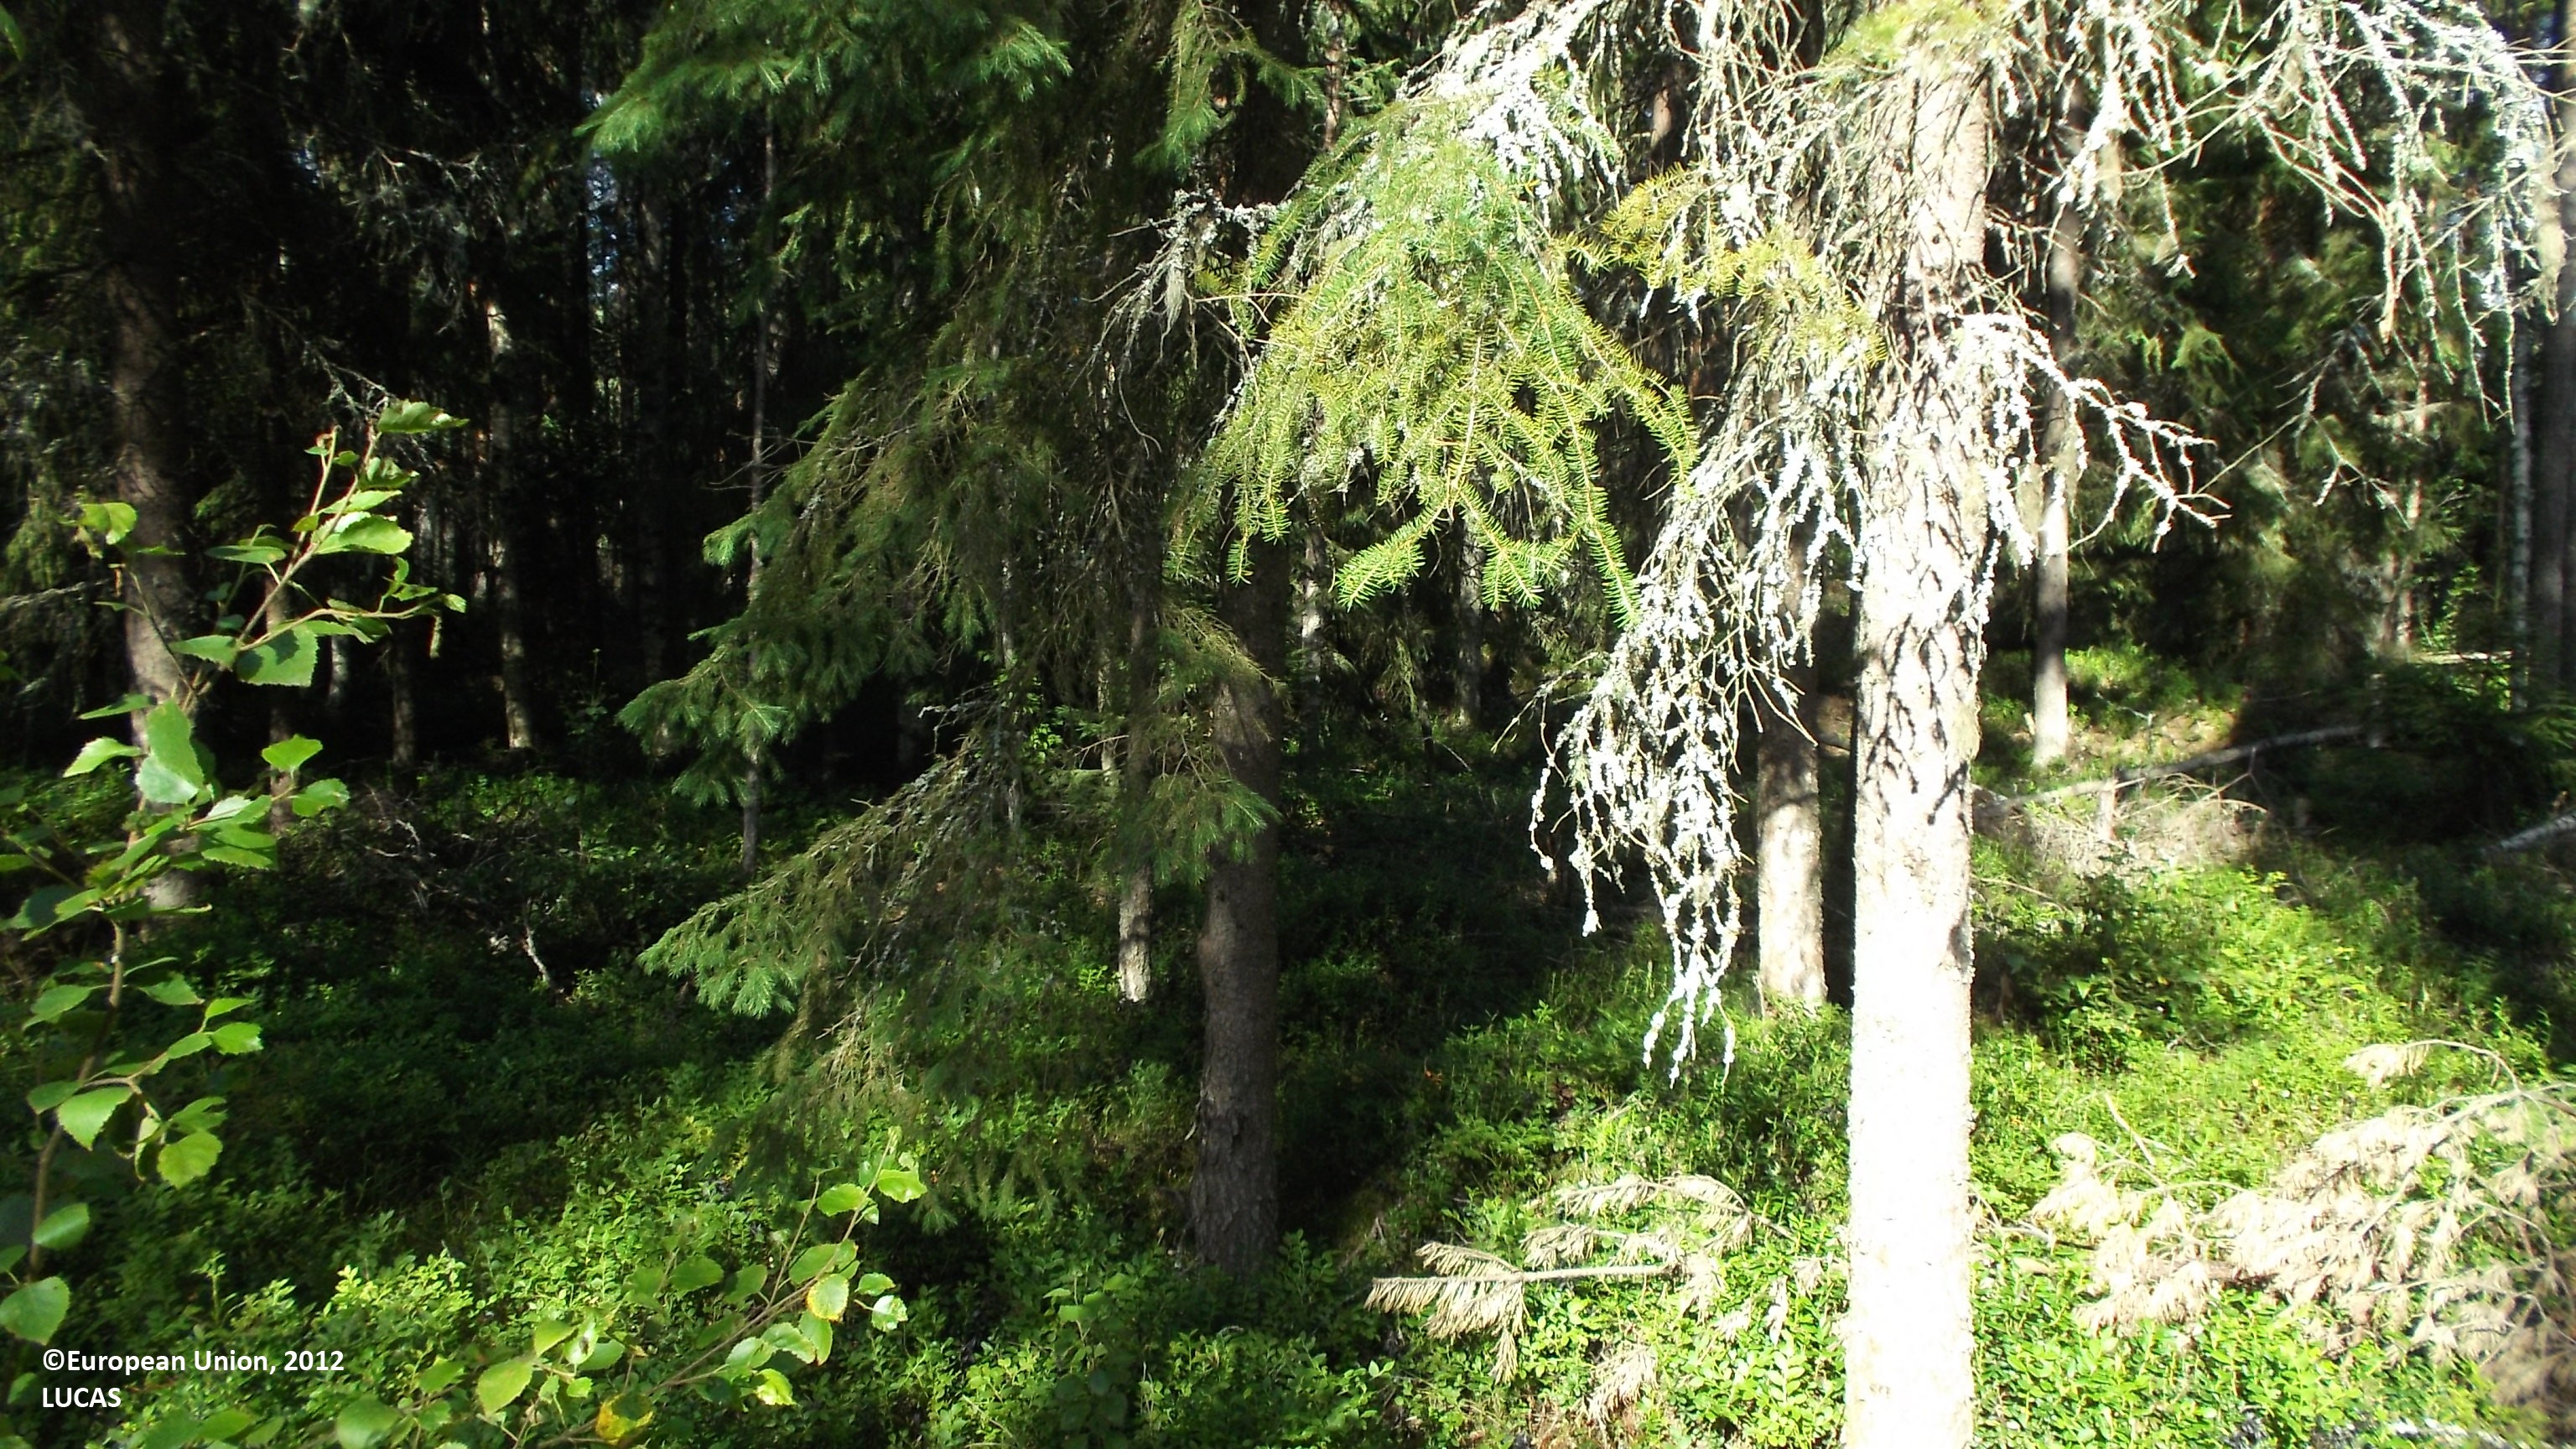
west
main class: Woodland
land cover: Other mixed woodland
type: boreal forest
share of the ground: 25 - 50 %
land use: Forestry
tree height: > 5 m
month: July
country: FI
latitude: 63.6125
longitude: 22.8981
